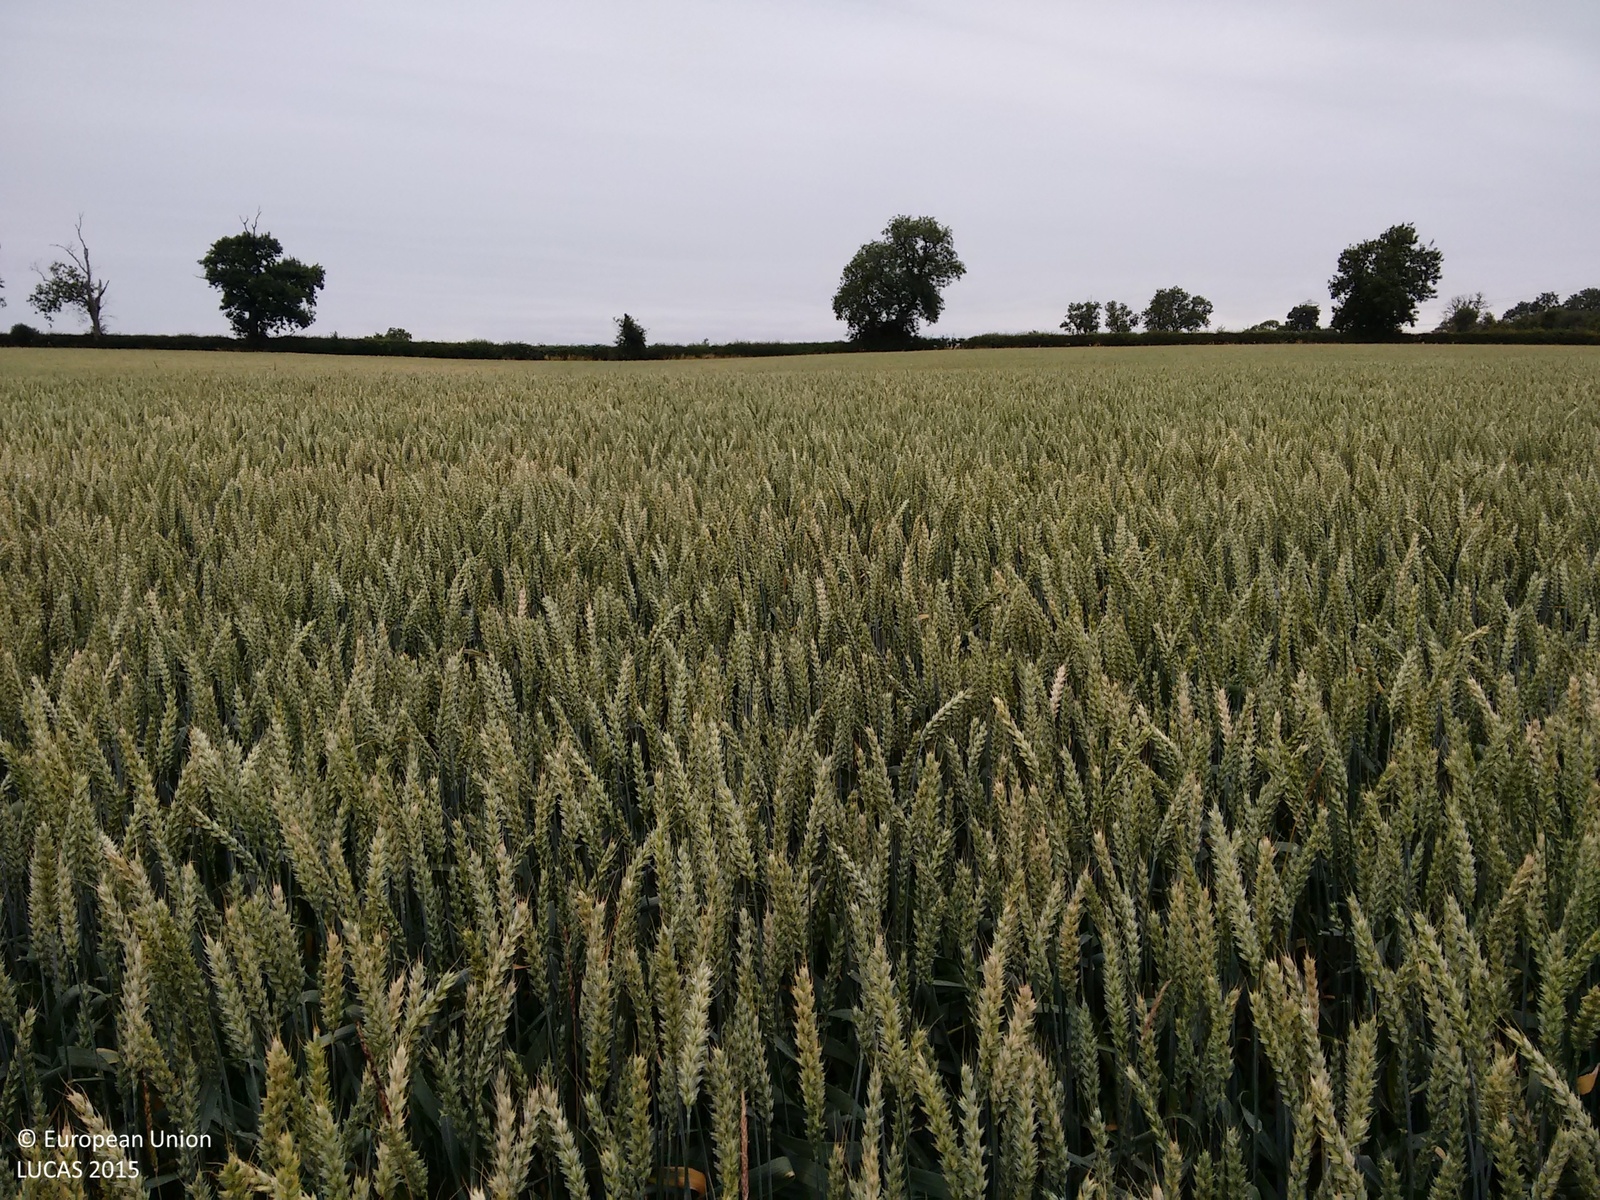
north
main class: Cropland
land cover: Common wheat
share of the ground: > 75 %
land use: Agriculture (excluding fallow land and kitchen gardens)
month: July
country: GB
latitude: 52.7395
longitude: -0.9596
